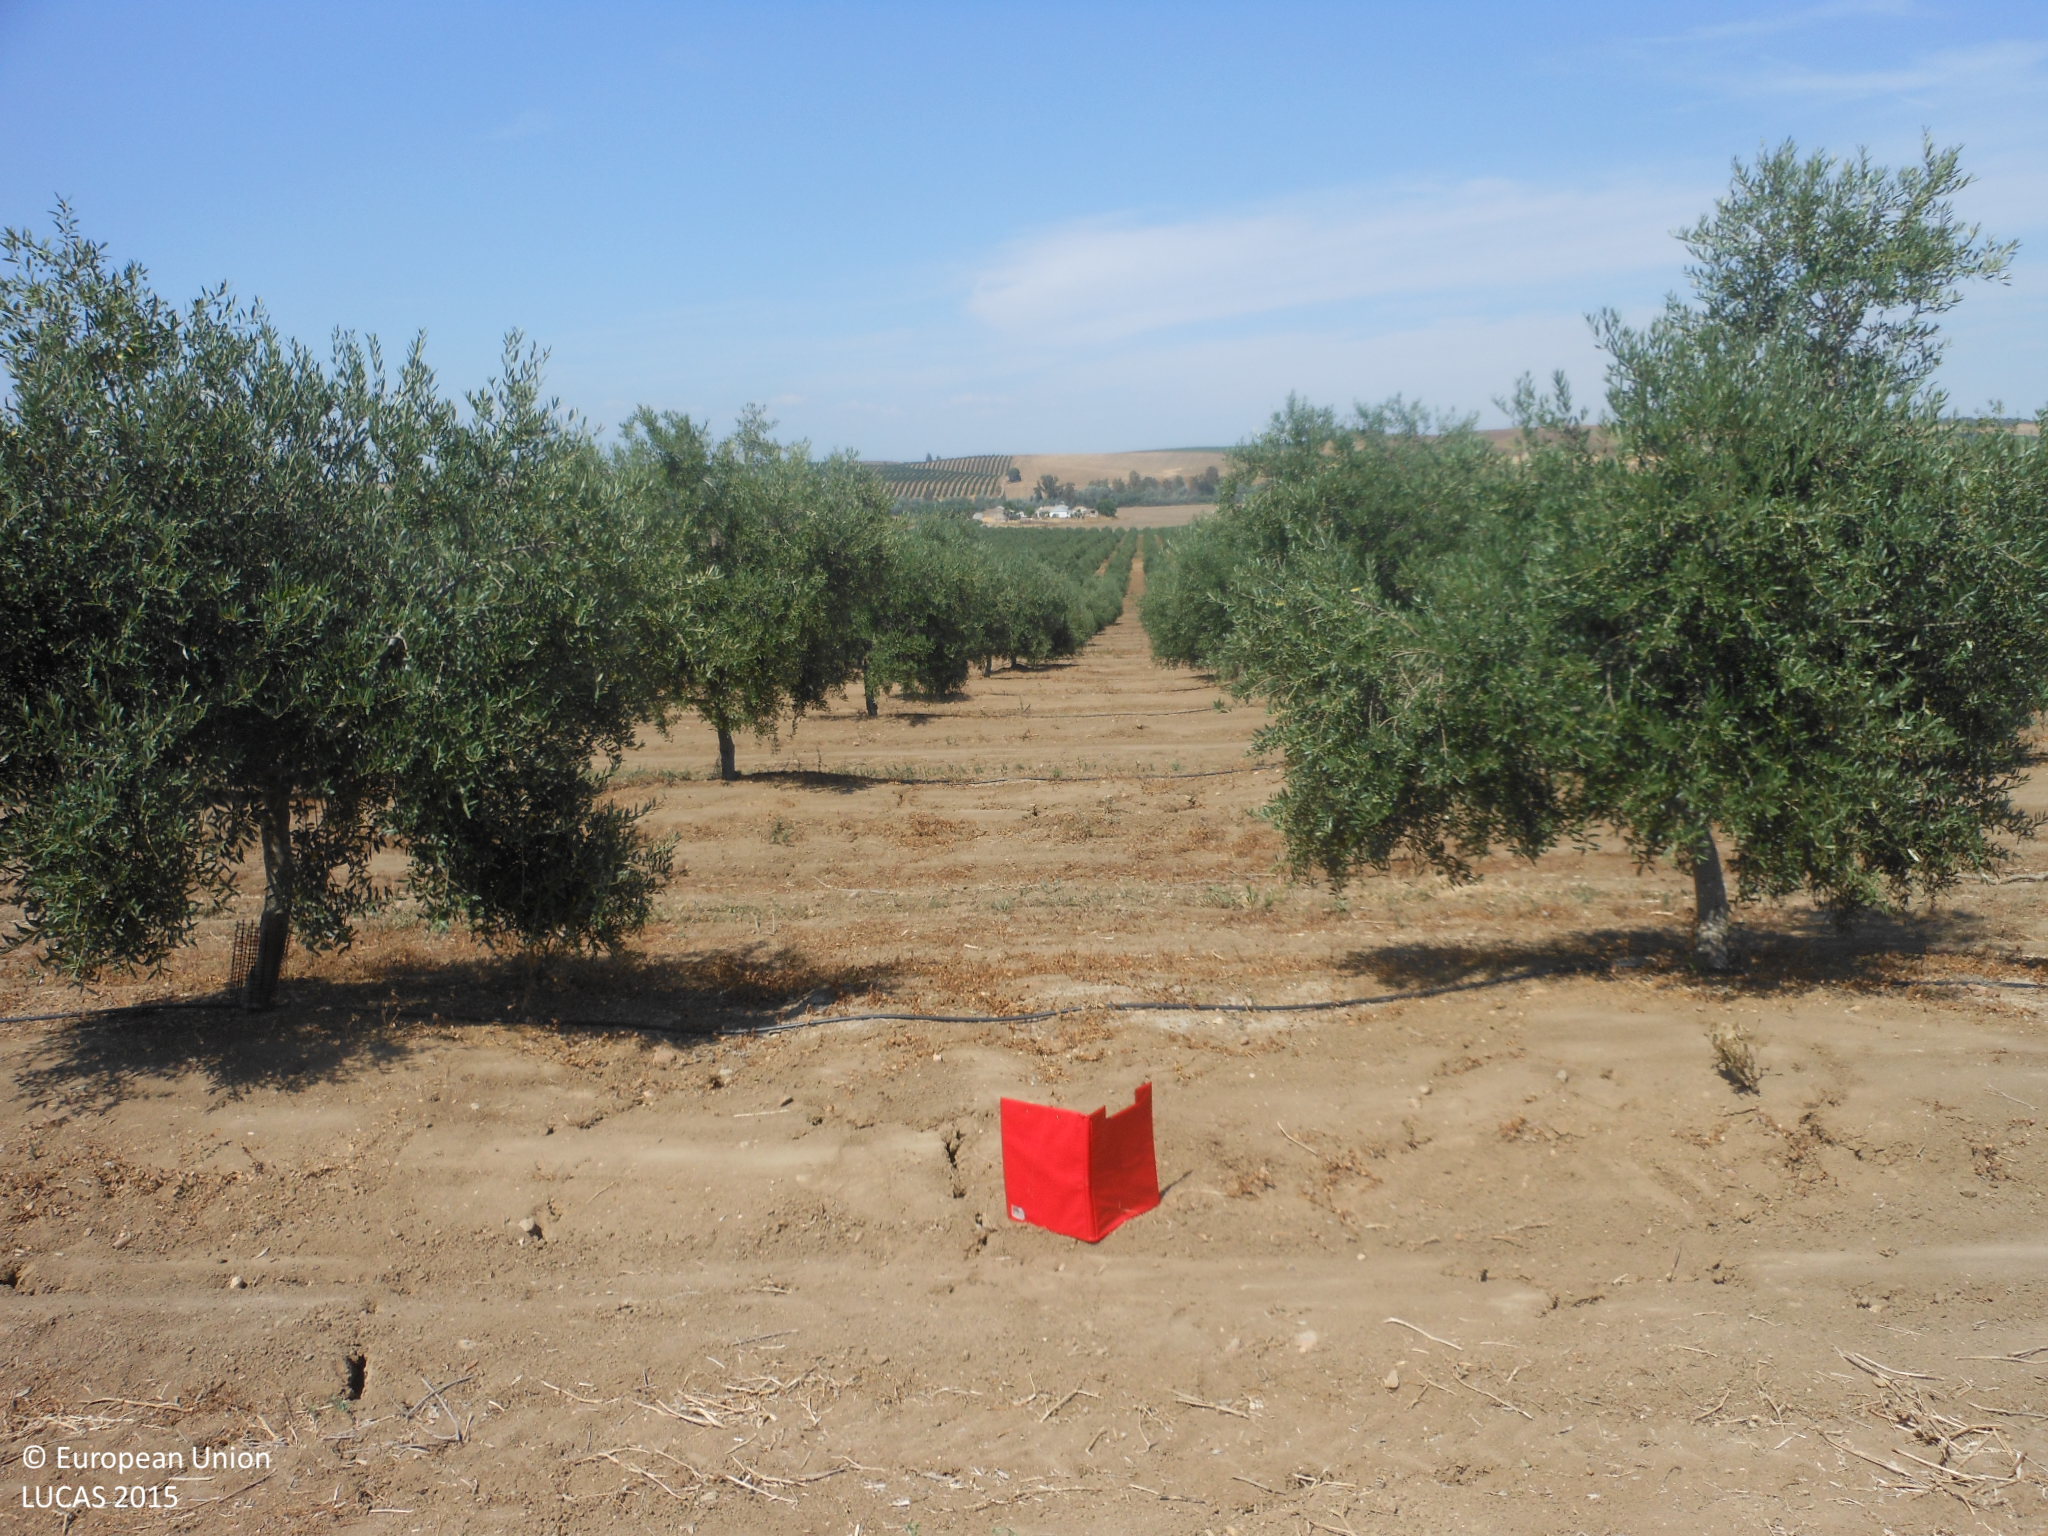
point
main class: Cropland
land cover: Olive groves
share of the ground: 50 - 75 %
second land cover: Other bare soil
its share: > 75 %
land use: Agriculture (excluding fallow land and kitchen gardens)
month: June
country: ES
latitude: 37.6424
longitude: -5.1910
